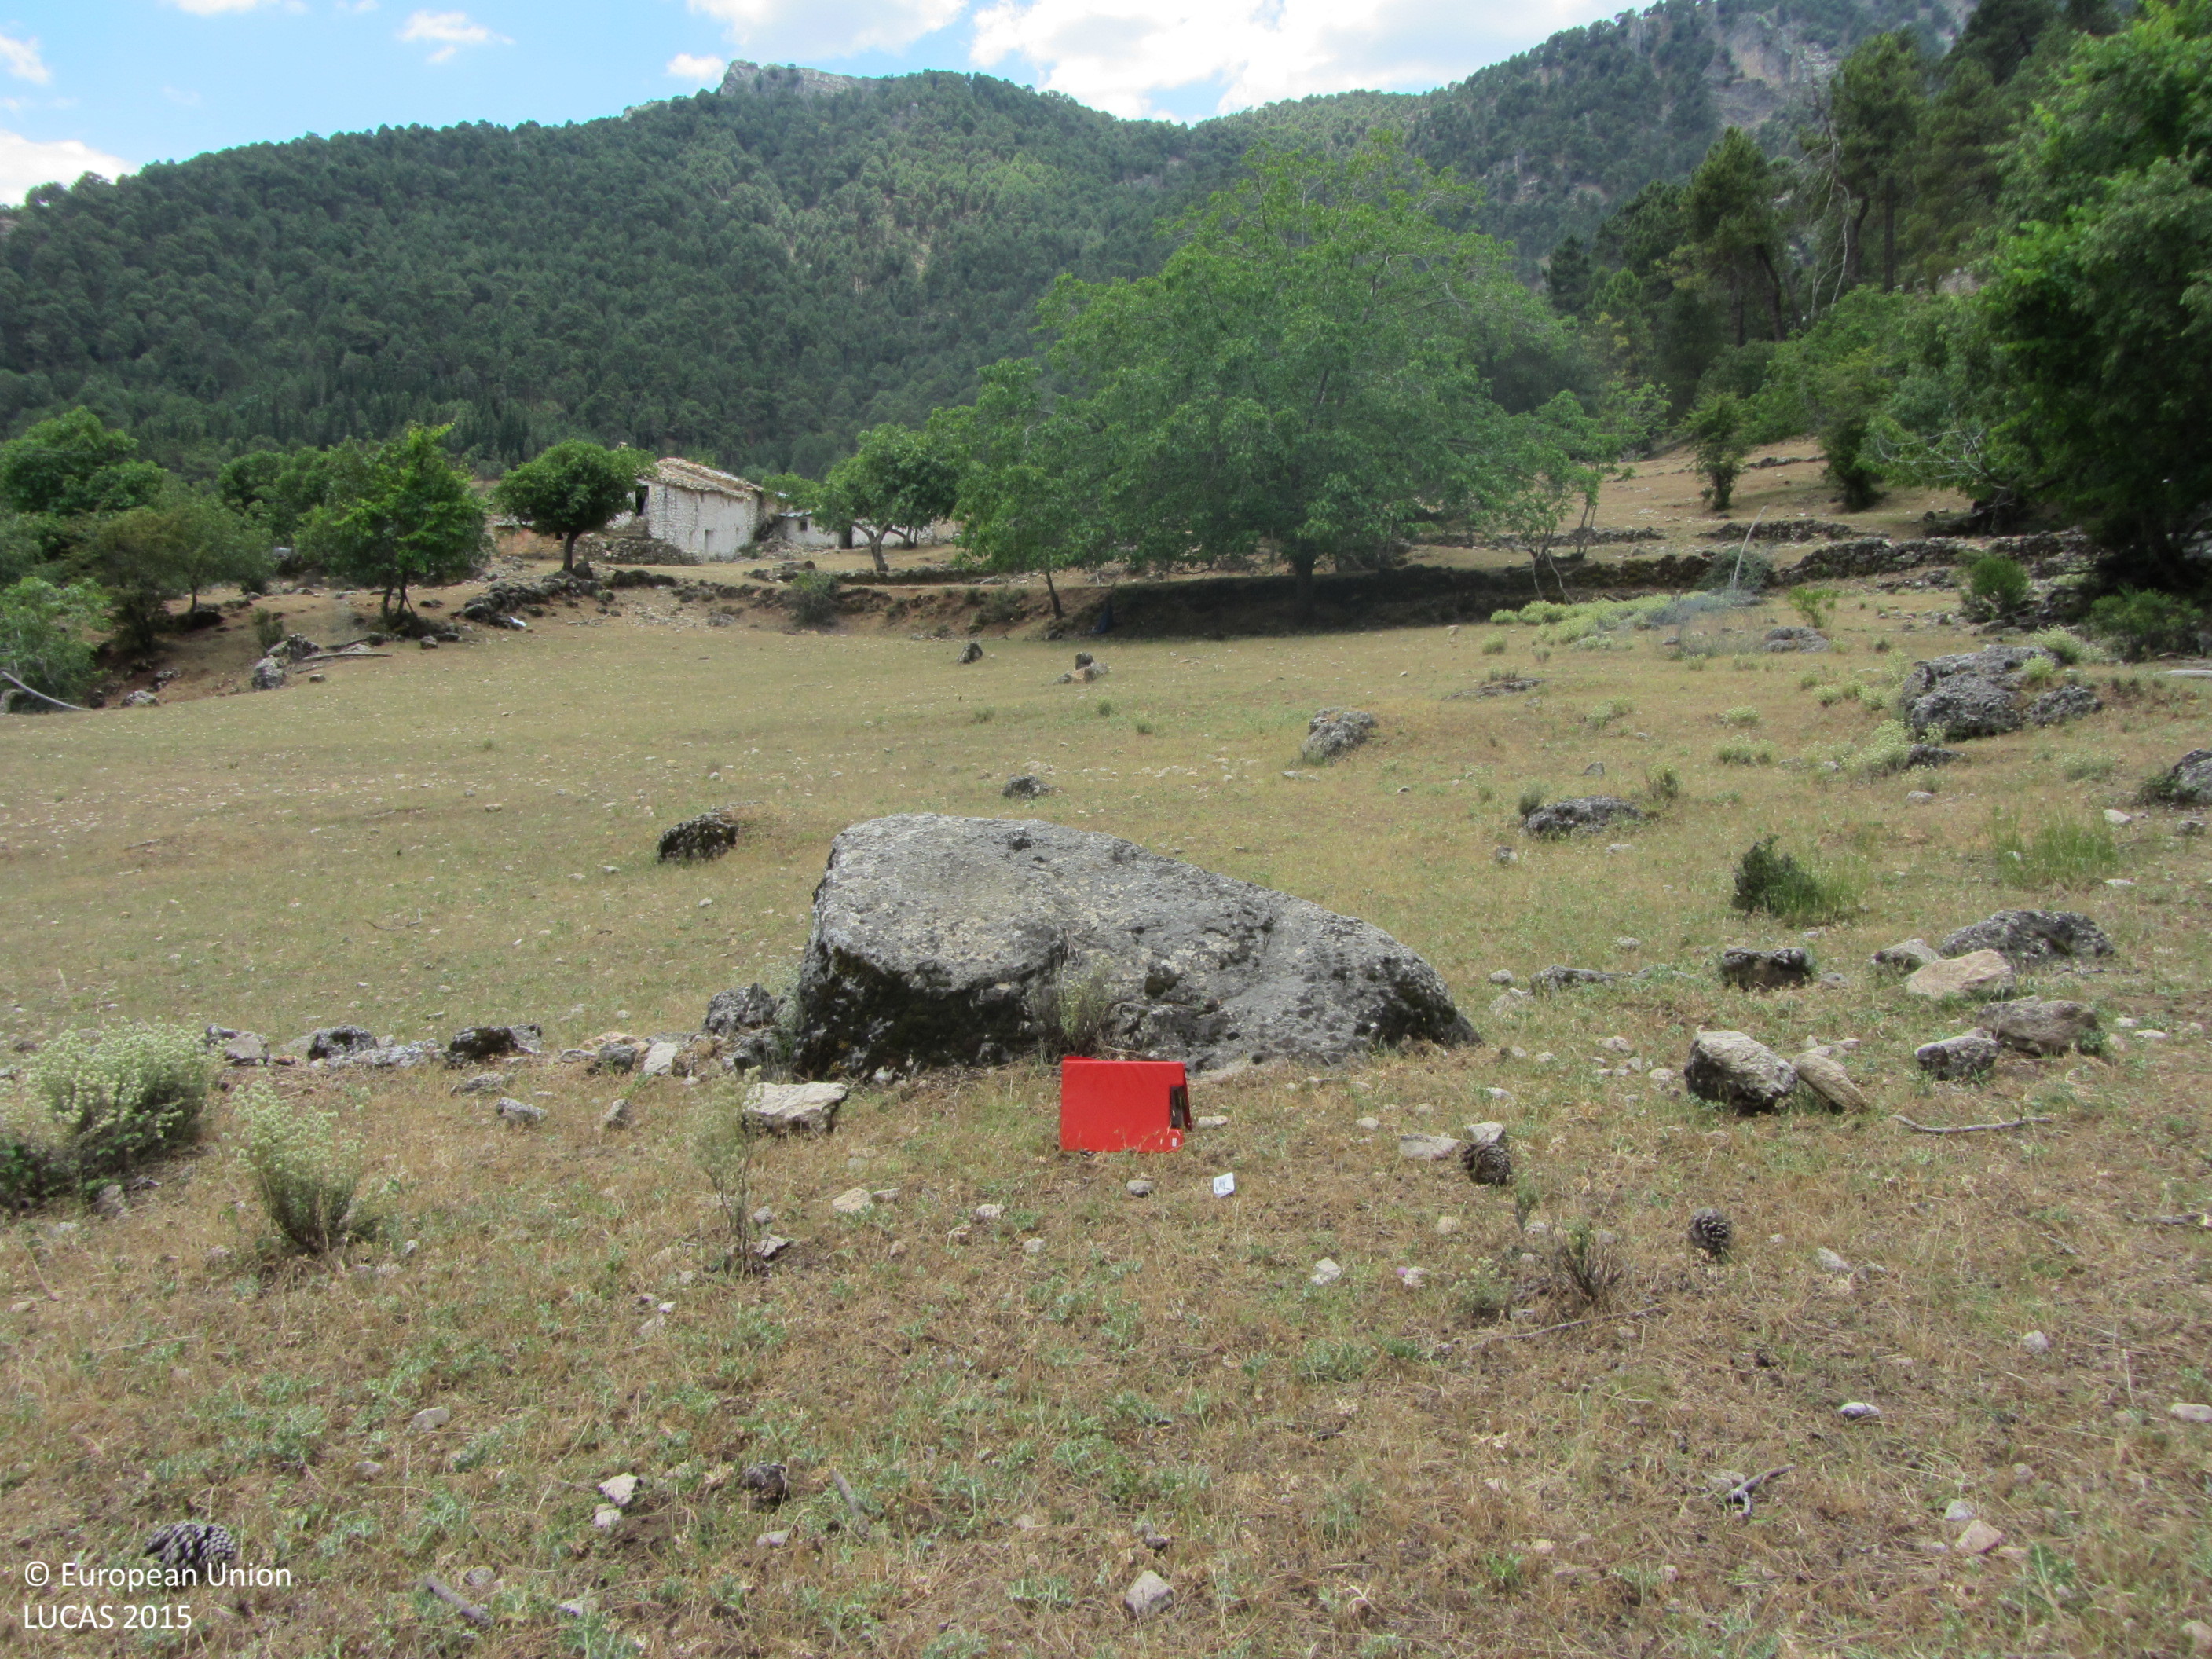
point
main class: Woodland
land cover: Pine dominated mixed woodland
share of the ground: > 75 %
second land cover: Grassland without tree/shrub cover
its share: > 75 %
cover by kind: herbaceous plants 60 %, broadleaved forest trees 20 %, coniferous forest trees 10 %, consolidated bare surface 10 %
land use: Forestry
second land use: Agriculture (excluding fallow land and kitchen gardens)
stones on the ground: < 10 %
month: June
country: ES
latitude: 37.9213
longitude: -2.9519
